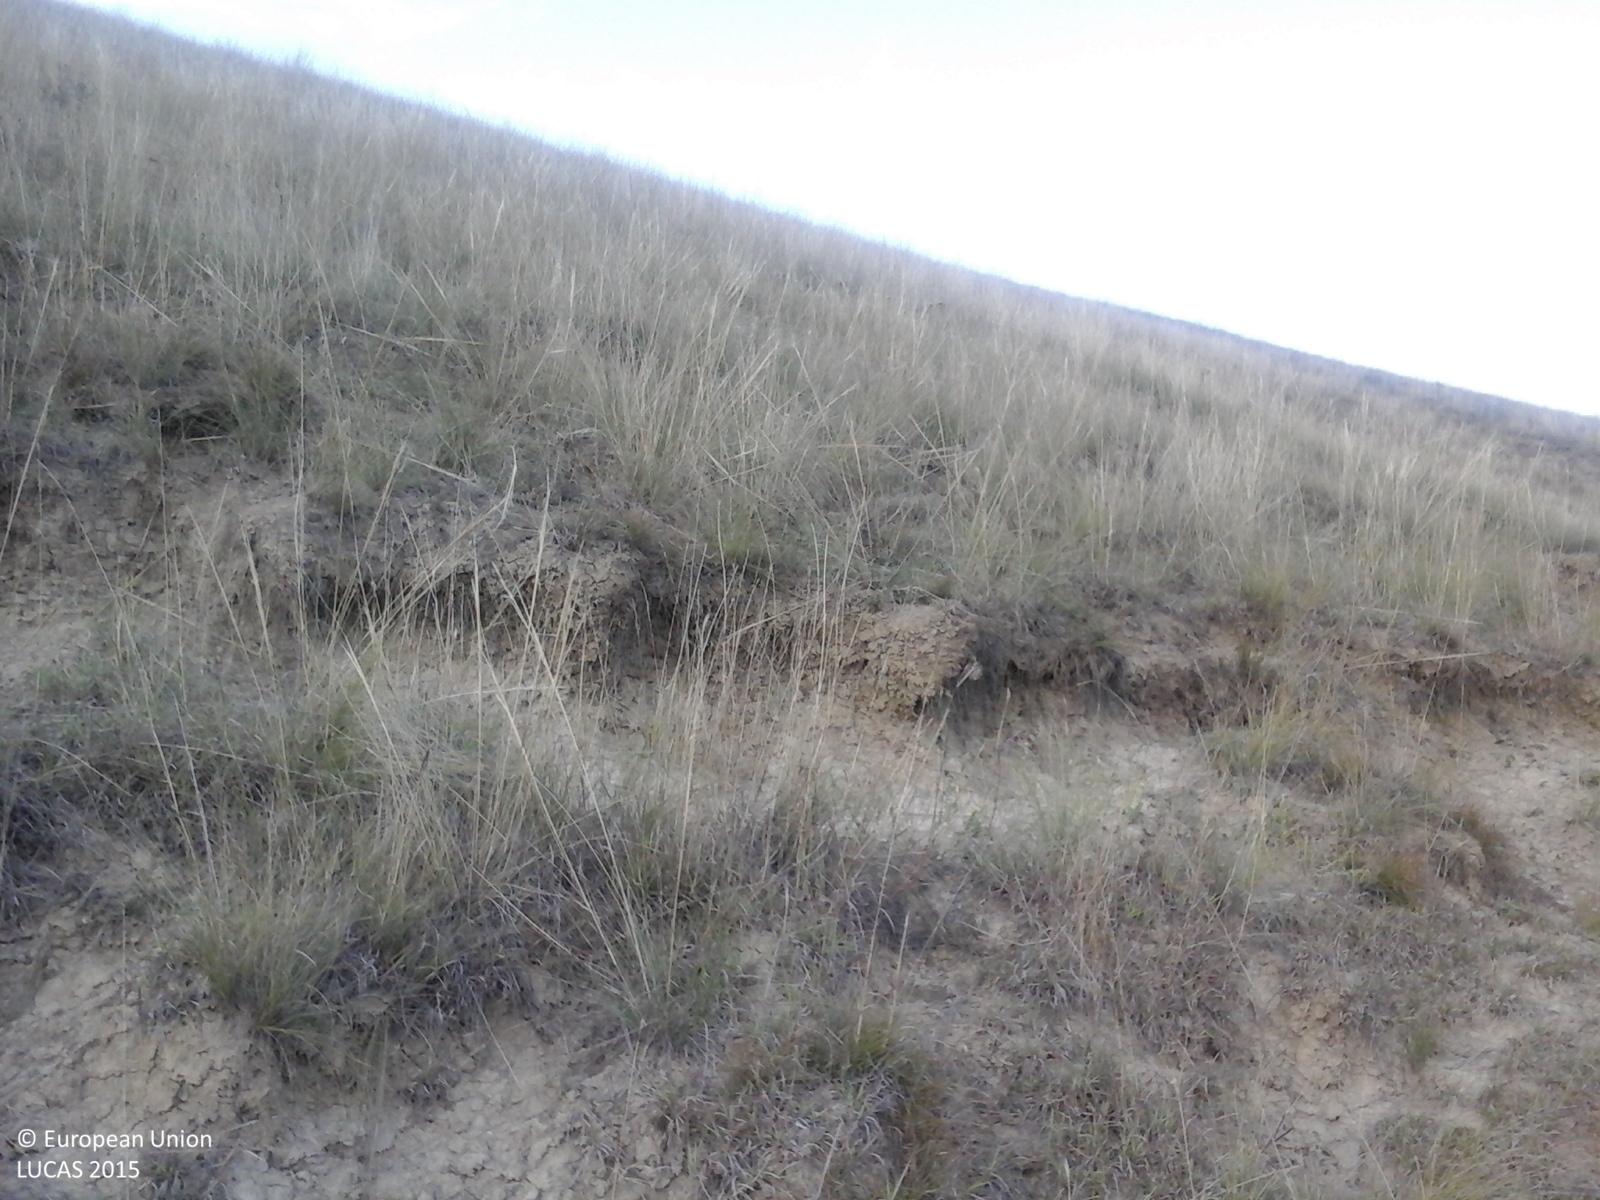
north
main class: Grassland
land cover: Grassland without tree/shrub cover
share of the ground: > 75 %
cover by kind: herbaceous plants 100 %
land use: Agriculture (excluding fallow land and kitchen gardens)
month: October
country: RO
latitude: 46.2582
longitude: 23.9157
